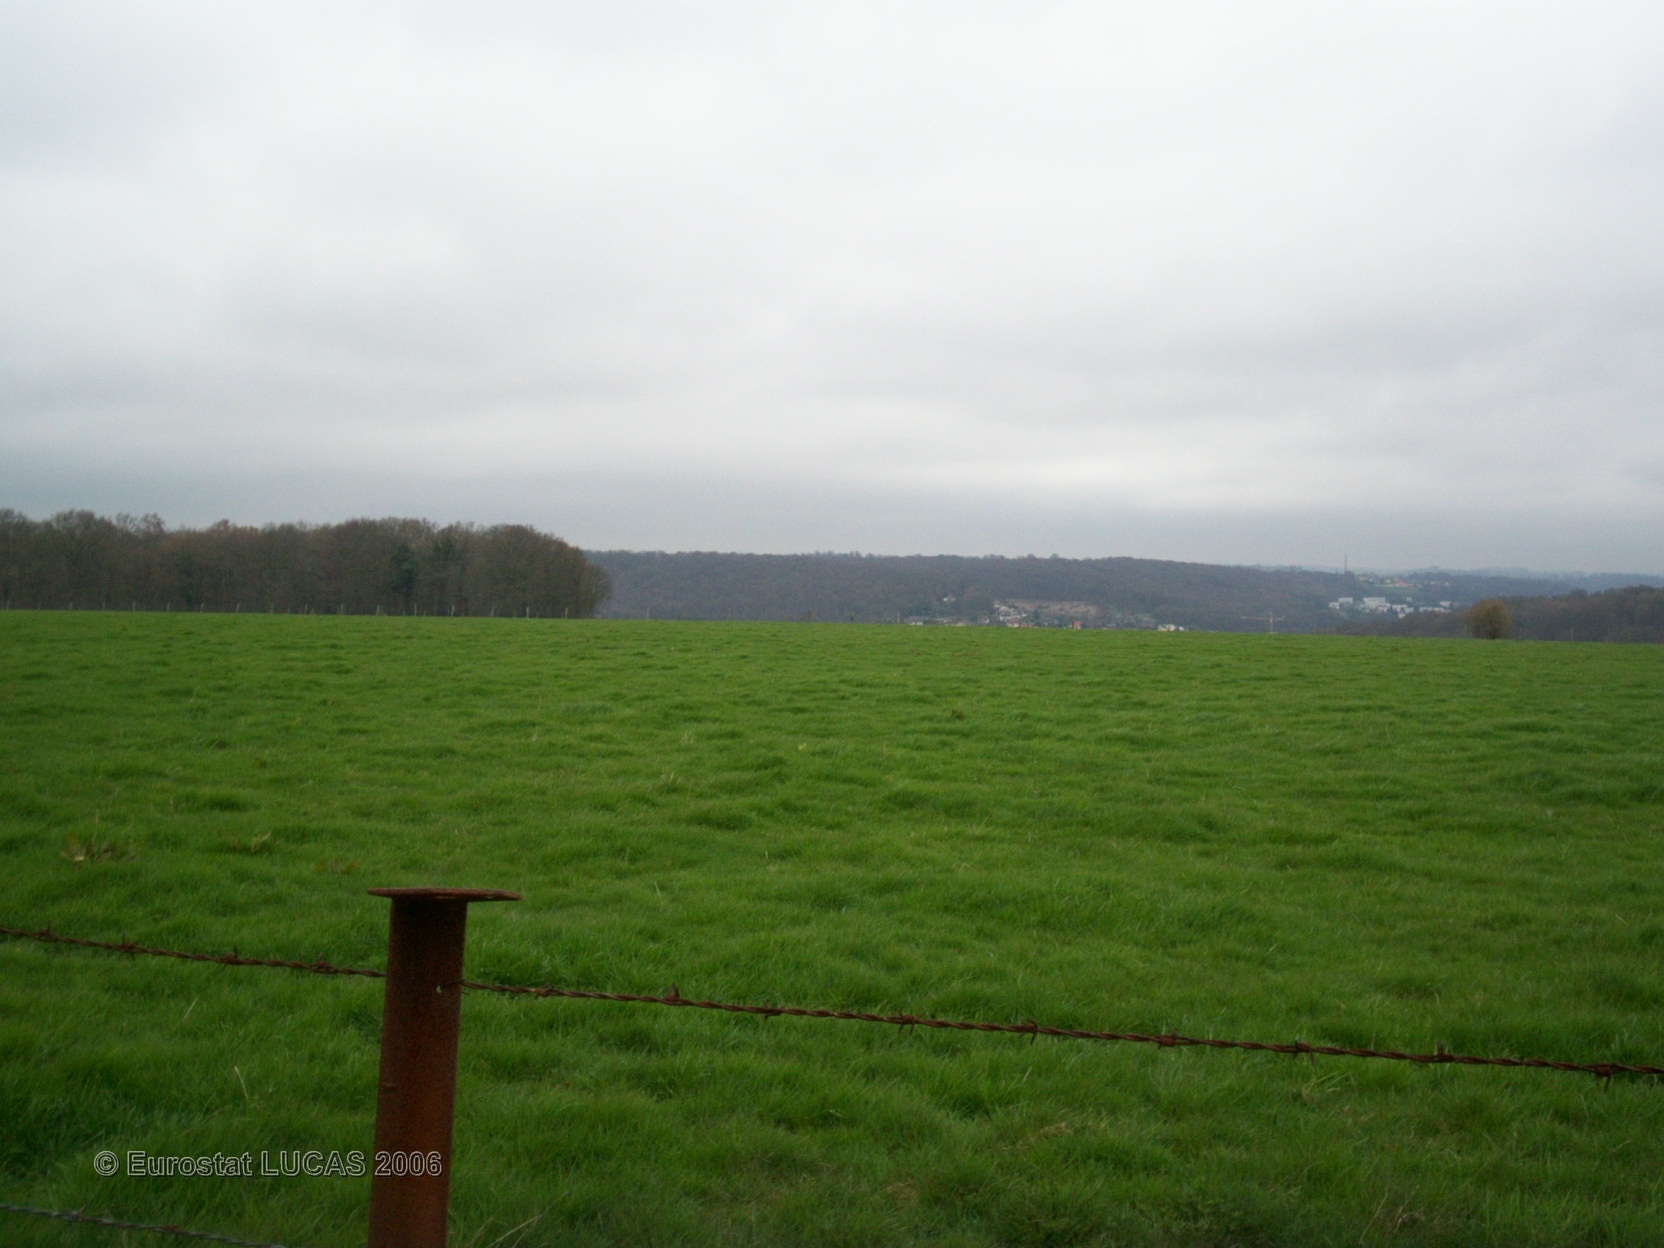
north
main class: Grassland
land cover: Grassland without tree/shrub cover
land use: Agriculture (excluding fallow land and kitchen gardens)
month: April
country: FR
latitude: 49.5145
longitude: 0.9302
